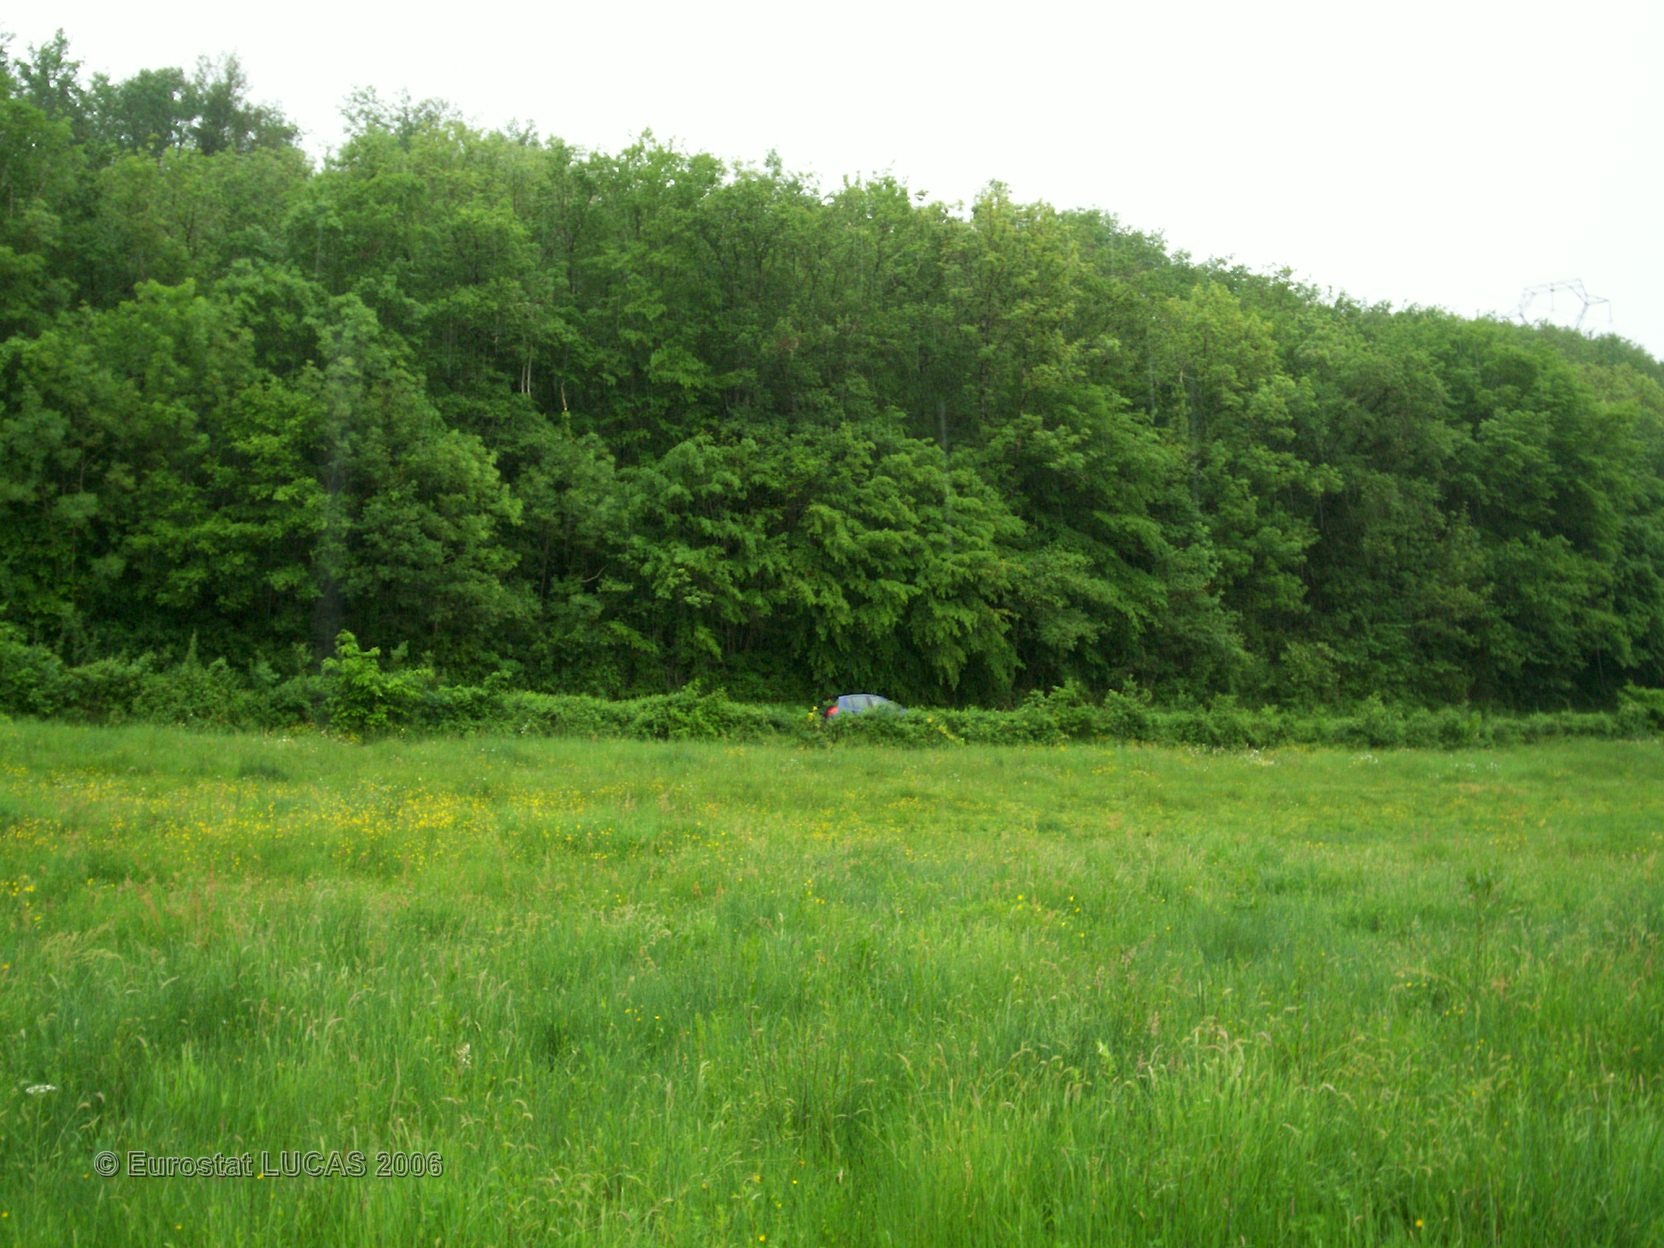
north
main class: Grassland
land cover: Grassland without tree/shrub cover
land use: Agriculture (excluding fallow land and kitchen gardens)
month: May
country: FR
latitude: 45.6603
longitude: 0.5536
